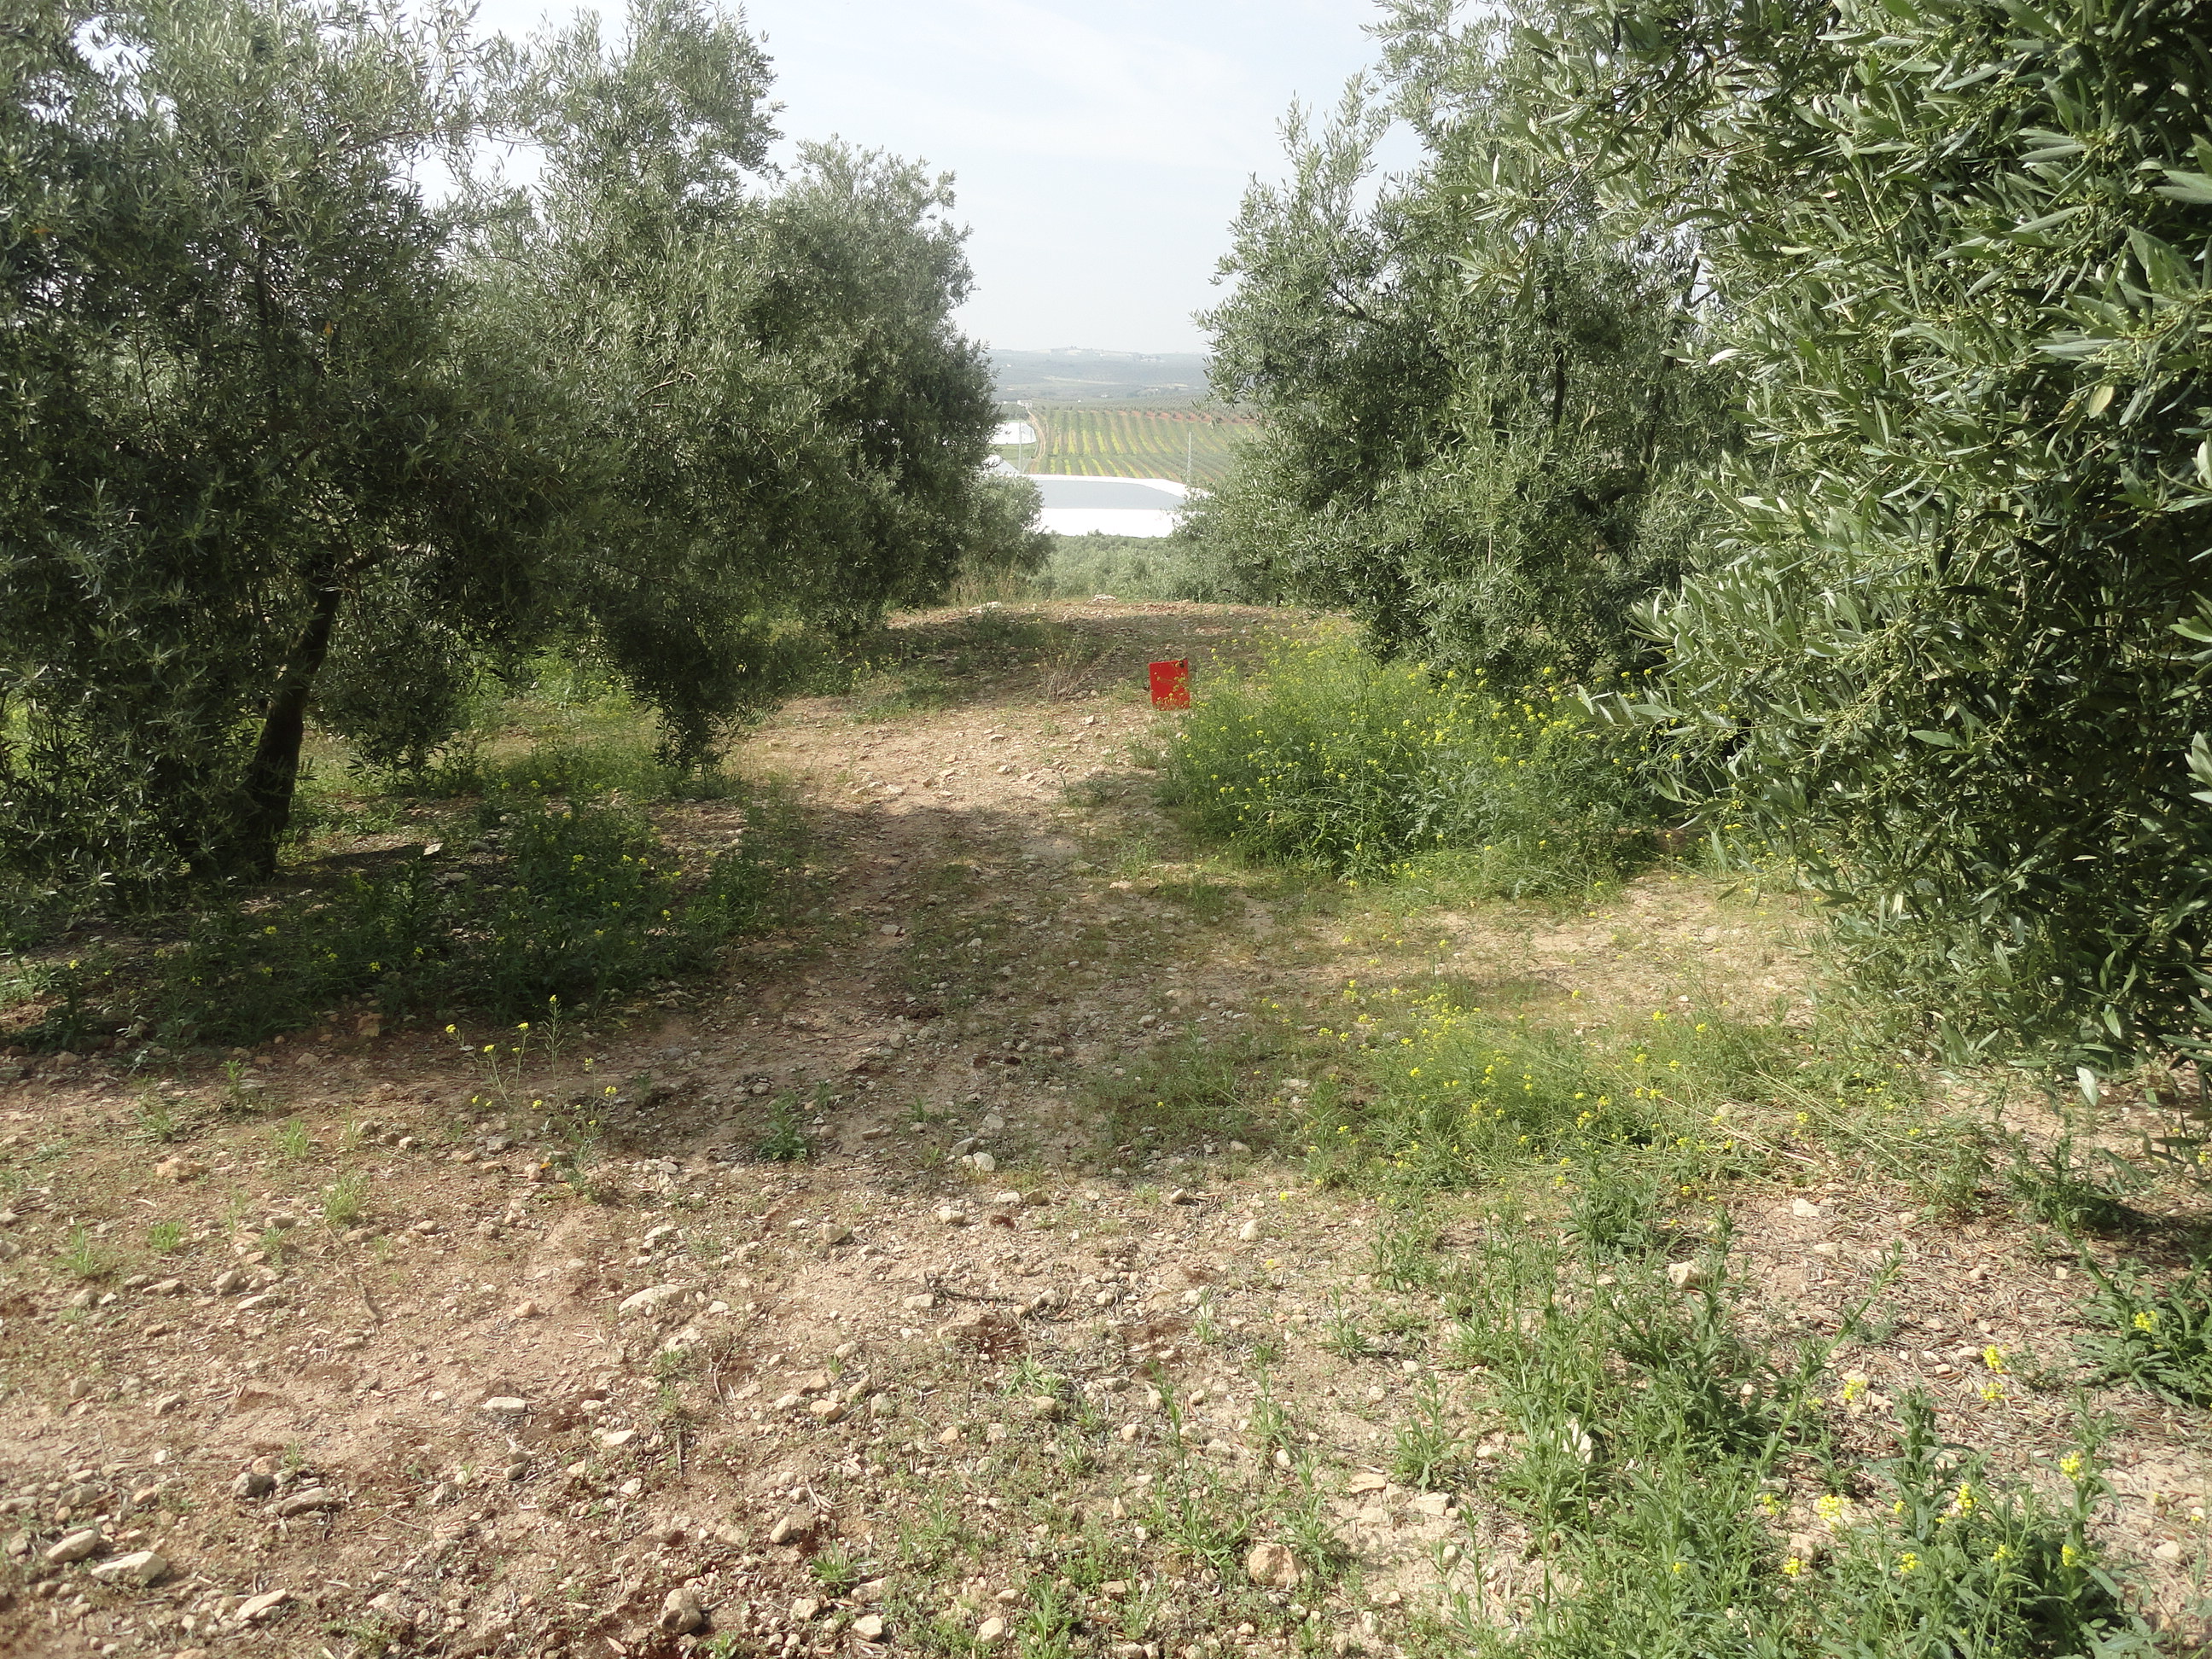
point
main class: Cropland
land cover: Olive groves
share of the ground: 50 - 75 %
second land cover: Spontaneously vegetated surfaces
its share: 25 - 50 %
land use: Agriculture (excluding fallow land and kitchen gardens)
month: April
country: ES
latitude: 37.4991
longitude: -4.5857
